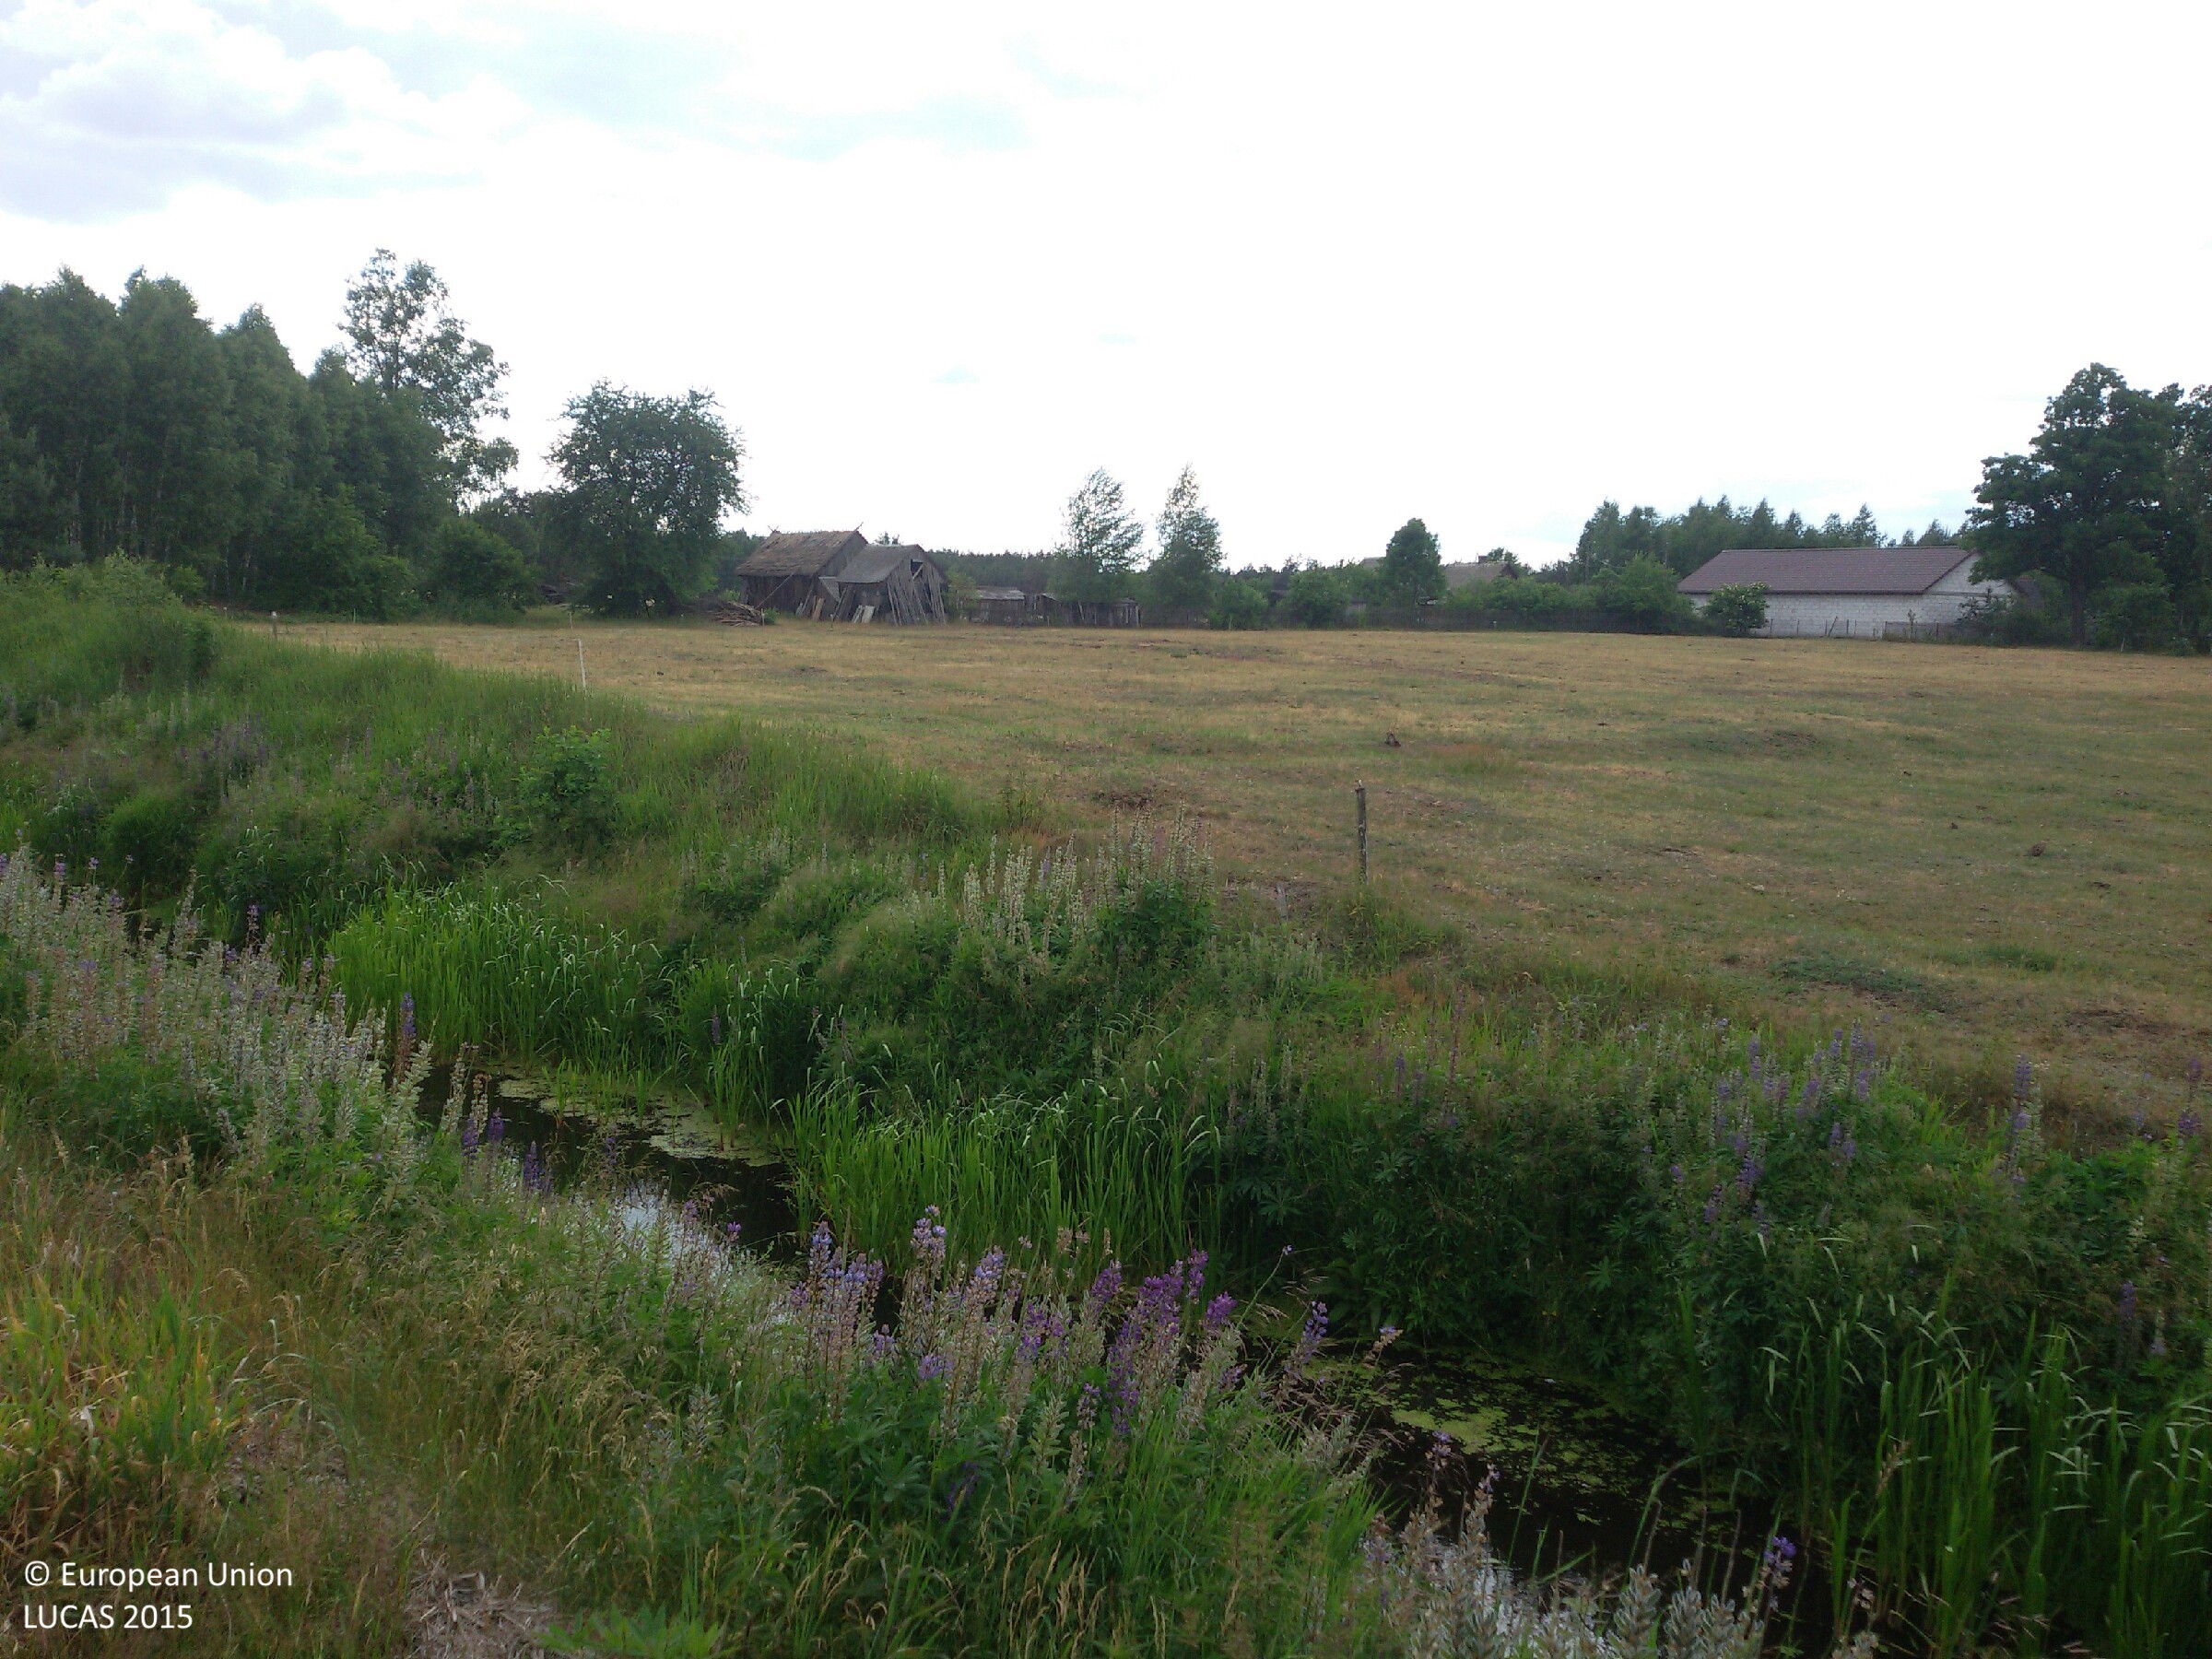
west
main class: Grassland
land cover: Grassland without tree/shrub cover
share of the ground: > 75 %
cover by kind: herbaceous plants 100 %
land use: Agriculture (excluding fallow land and kitchen gardens)
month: June
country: PL
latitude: 53.2824
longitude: 20.9774
